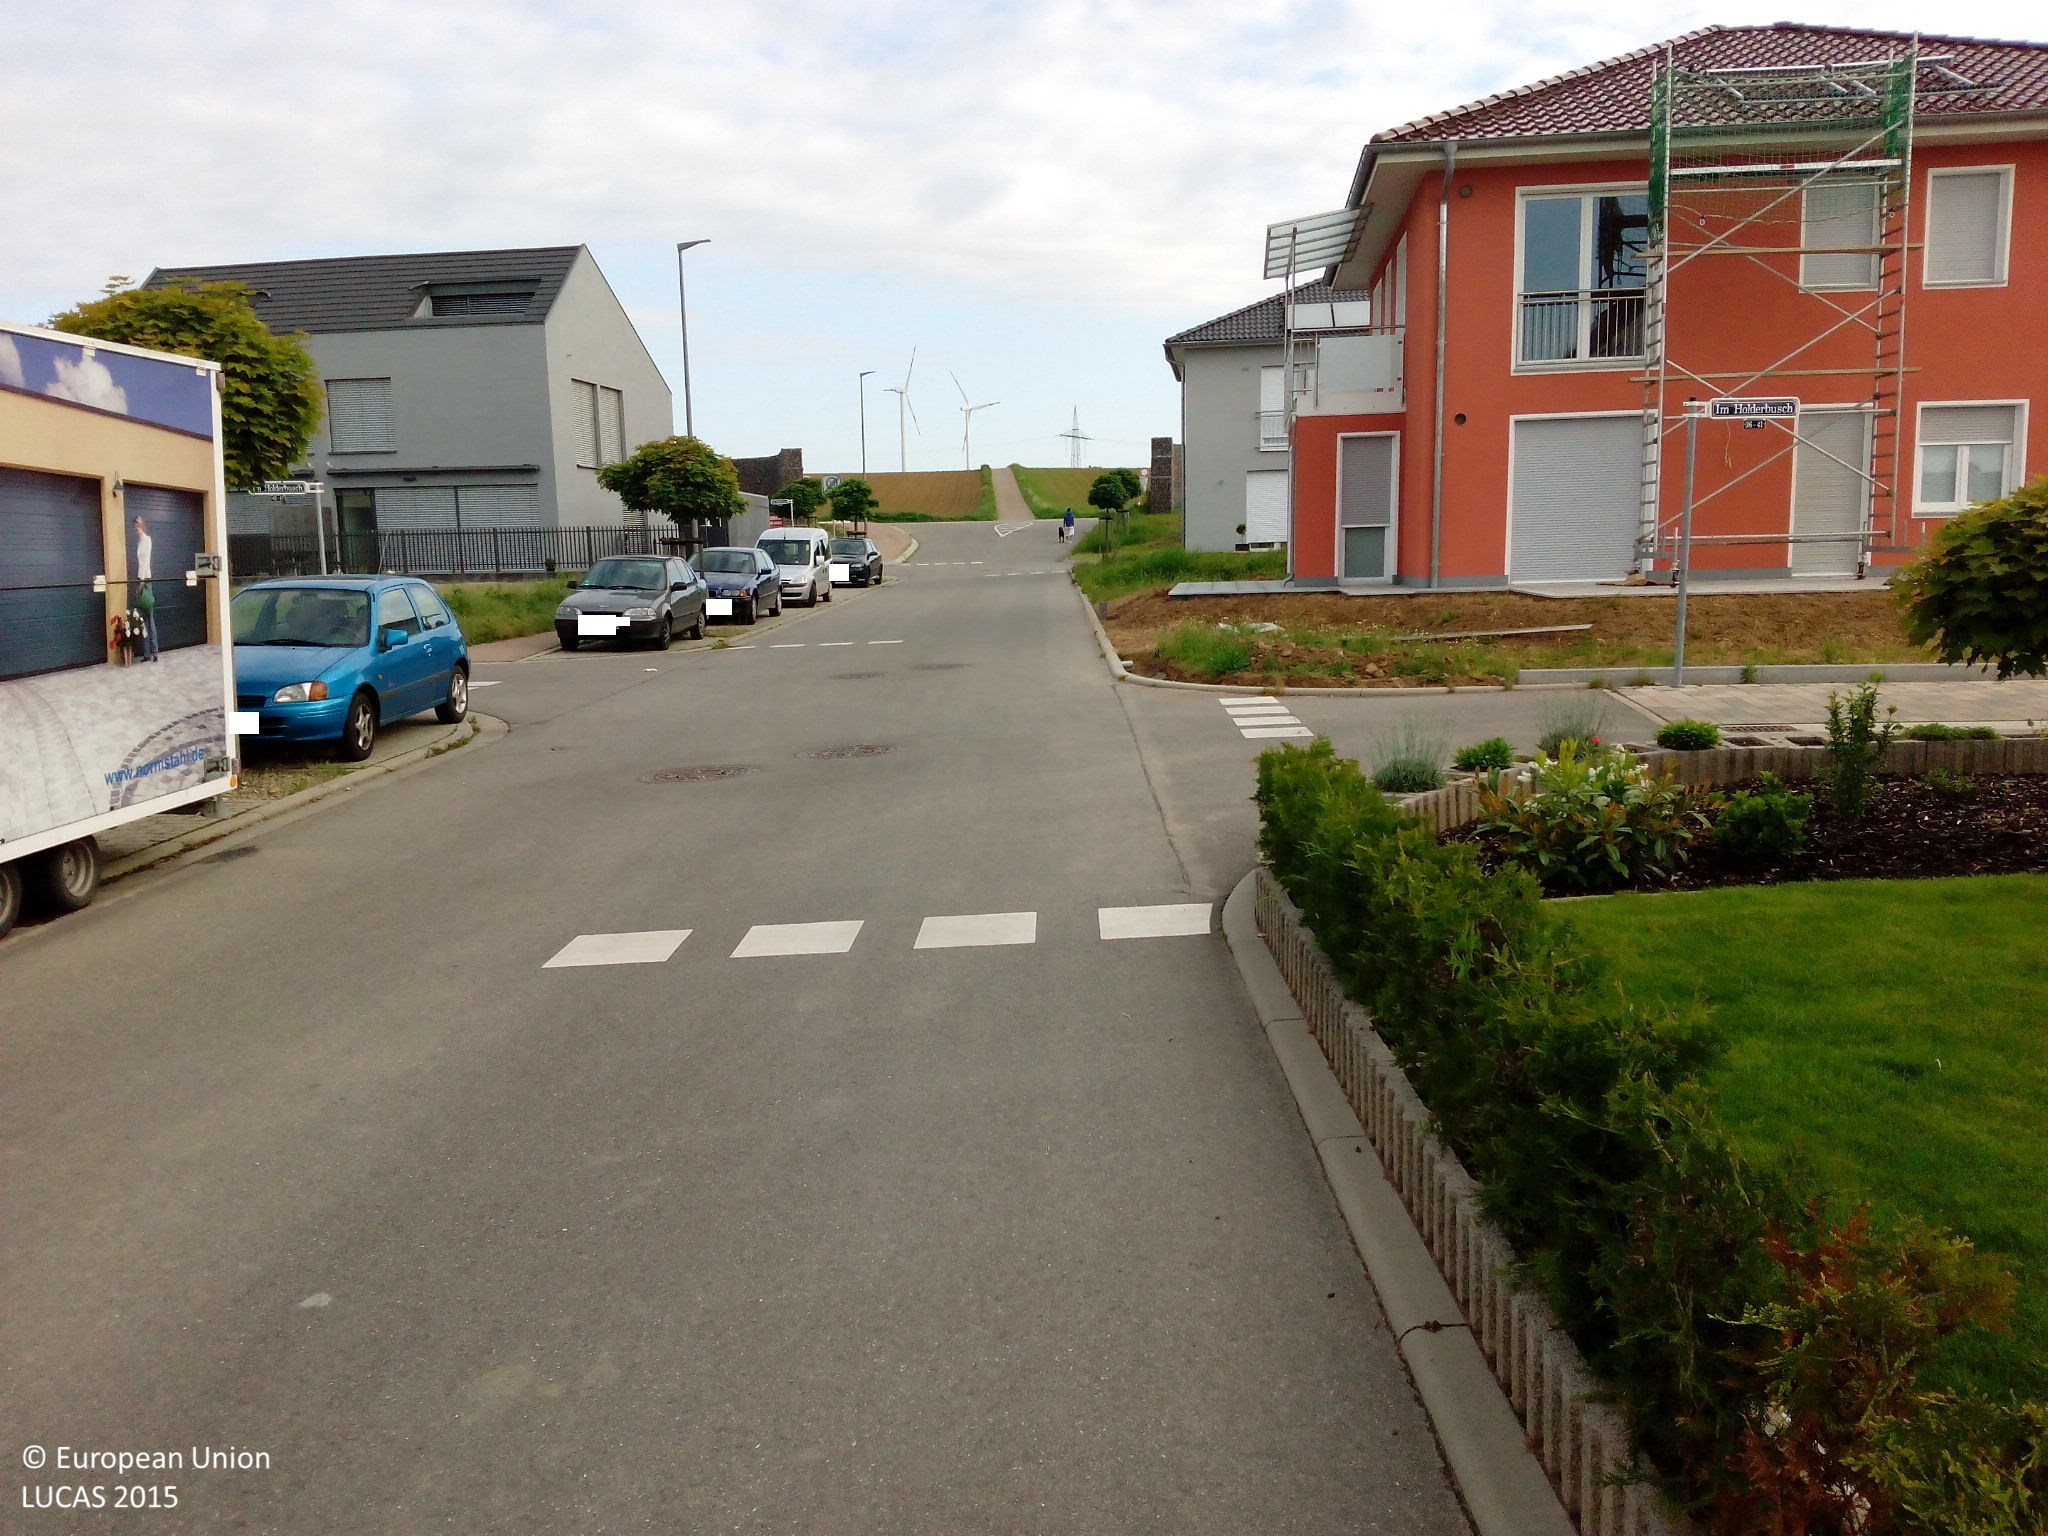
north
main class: Grassland
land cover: Grassland without tree/shrub cover
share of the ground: > 75 %
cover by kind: herbaceous plants 95 %, unconsolidated bare surface 5 %
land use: Residential
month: May
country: DE
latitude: 49.0719
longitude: 8.1526
